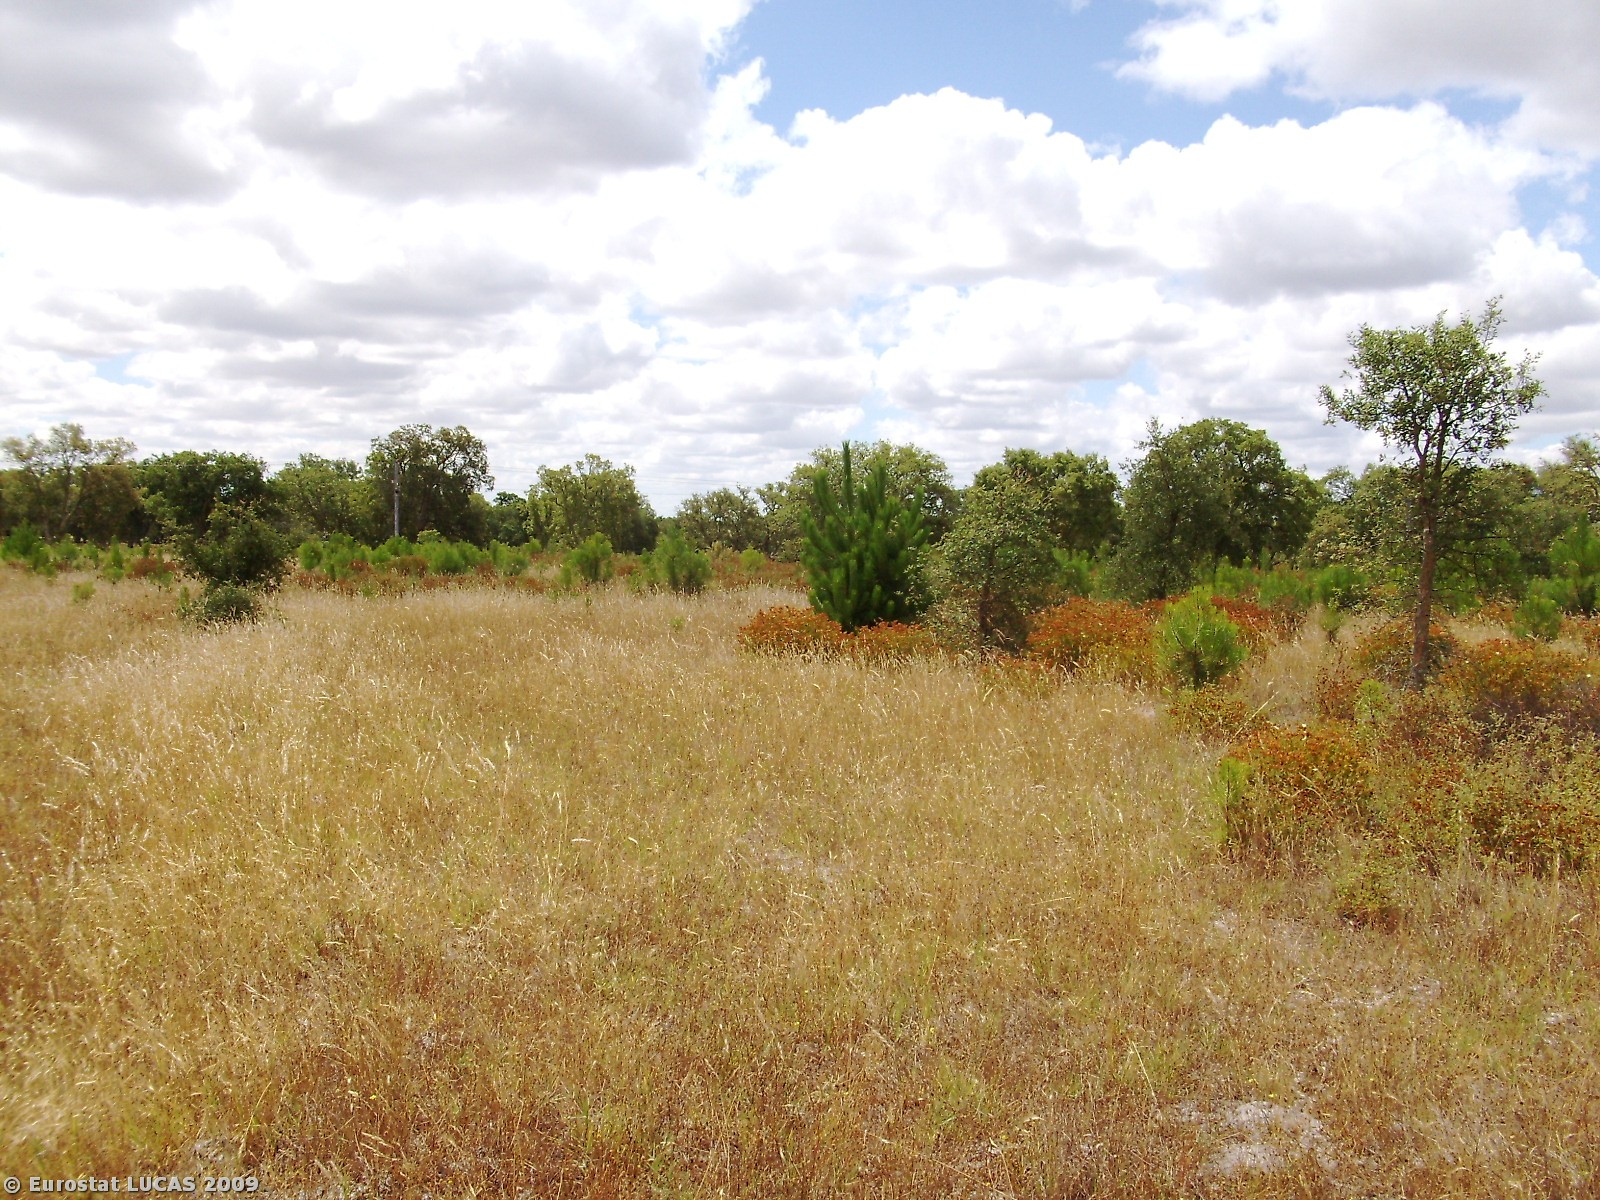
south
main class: Woodland
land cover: Broadleaved woodland
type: broadleaved evergreen forest
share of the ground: 10 - 25 %
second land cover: Spontaneously vegetated surfaces
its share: > 75 %
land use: Forestry
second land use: Fallow land
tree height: > 5 m
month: June
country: PT
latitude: 37.9817
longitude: -8.4511
